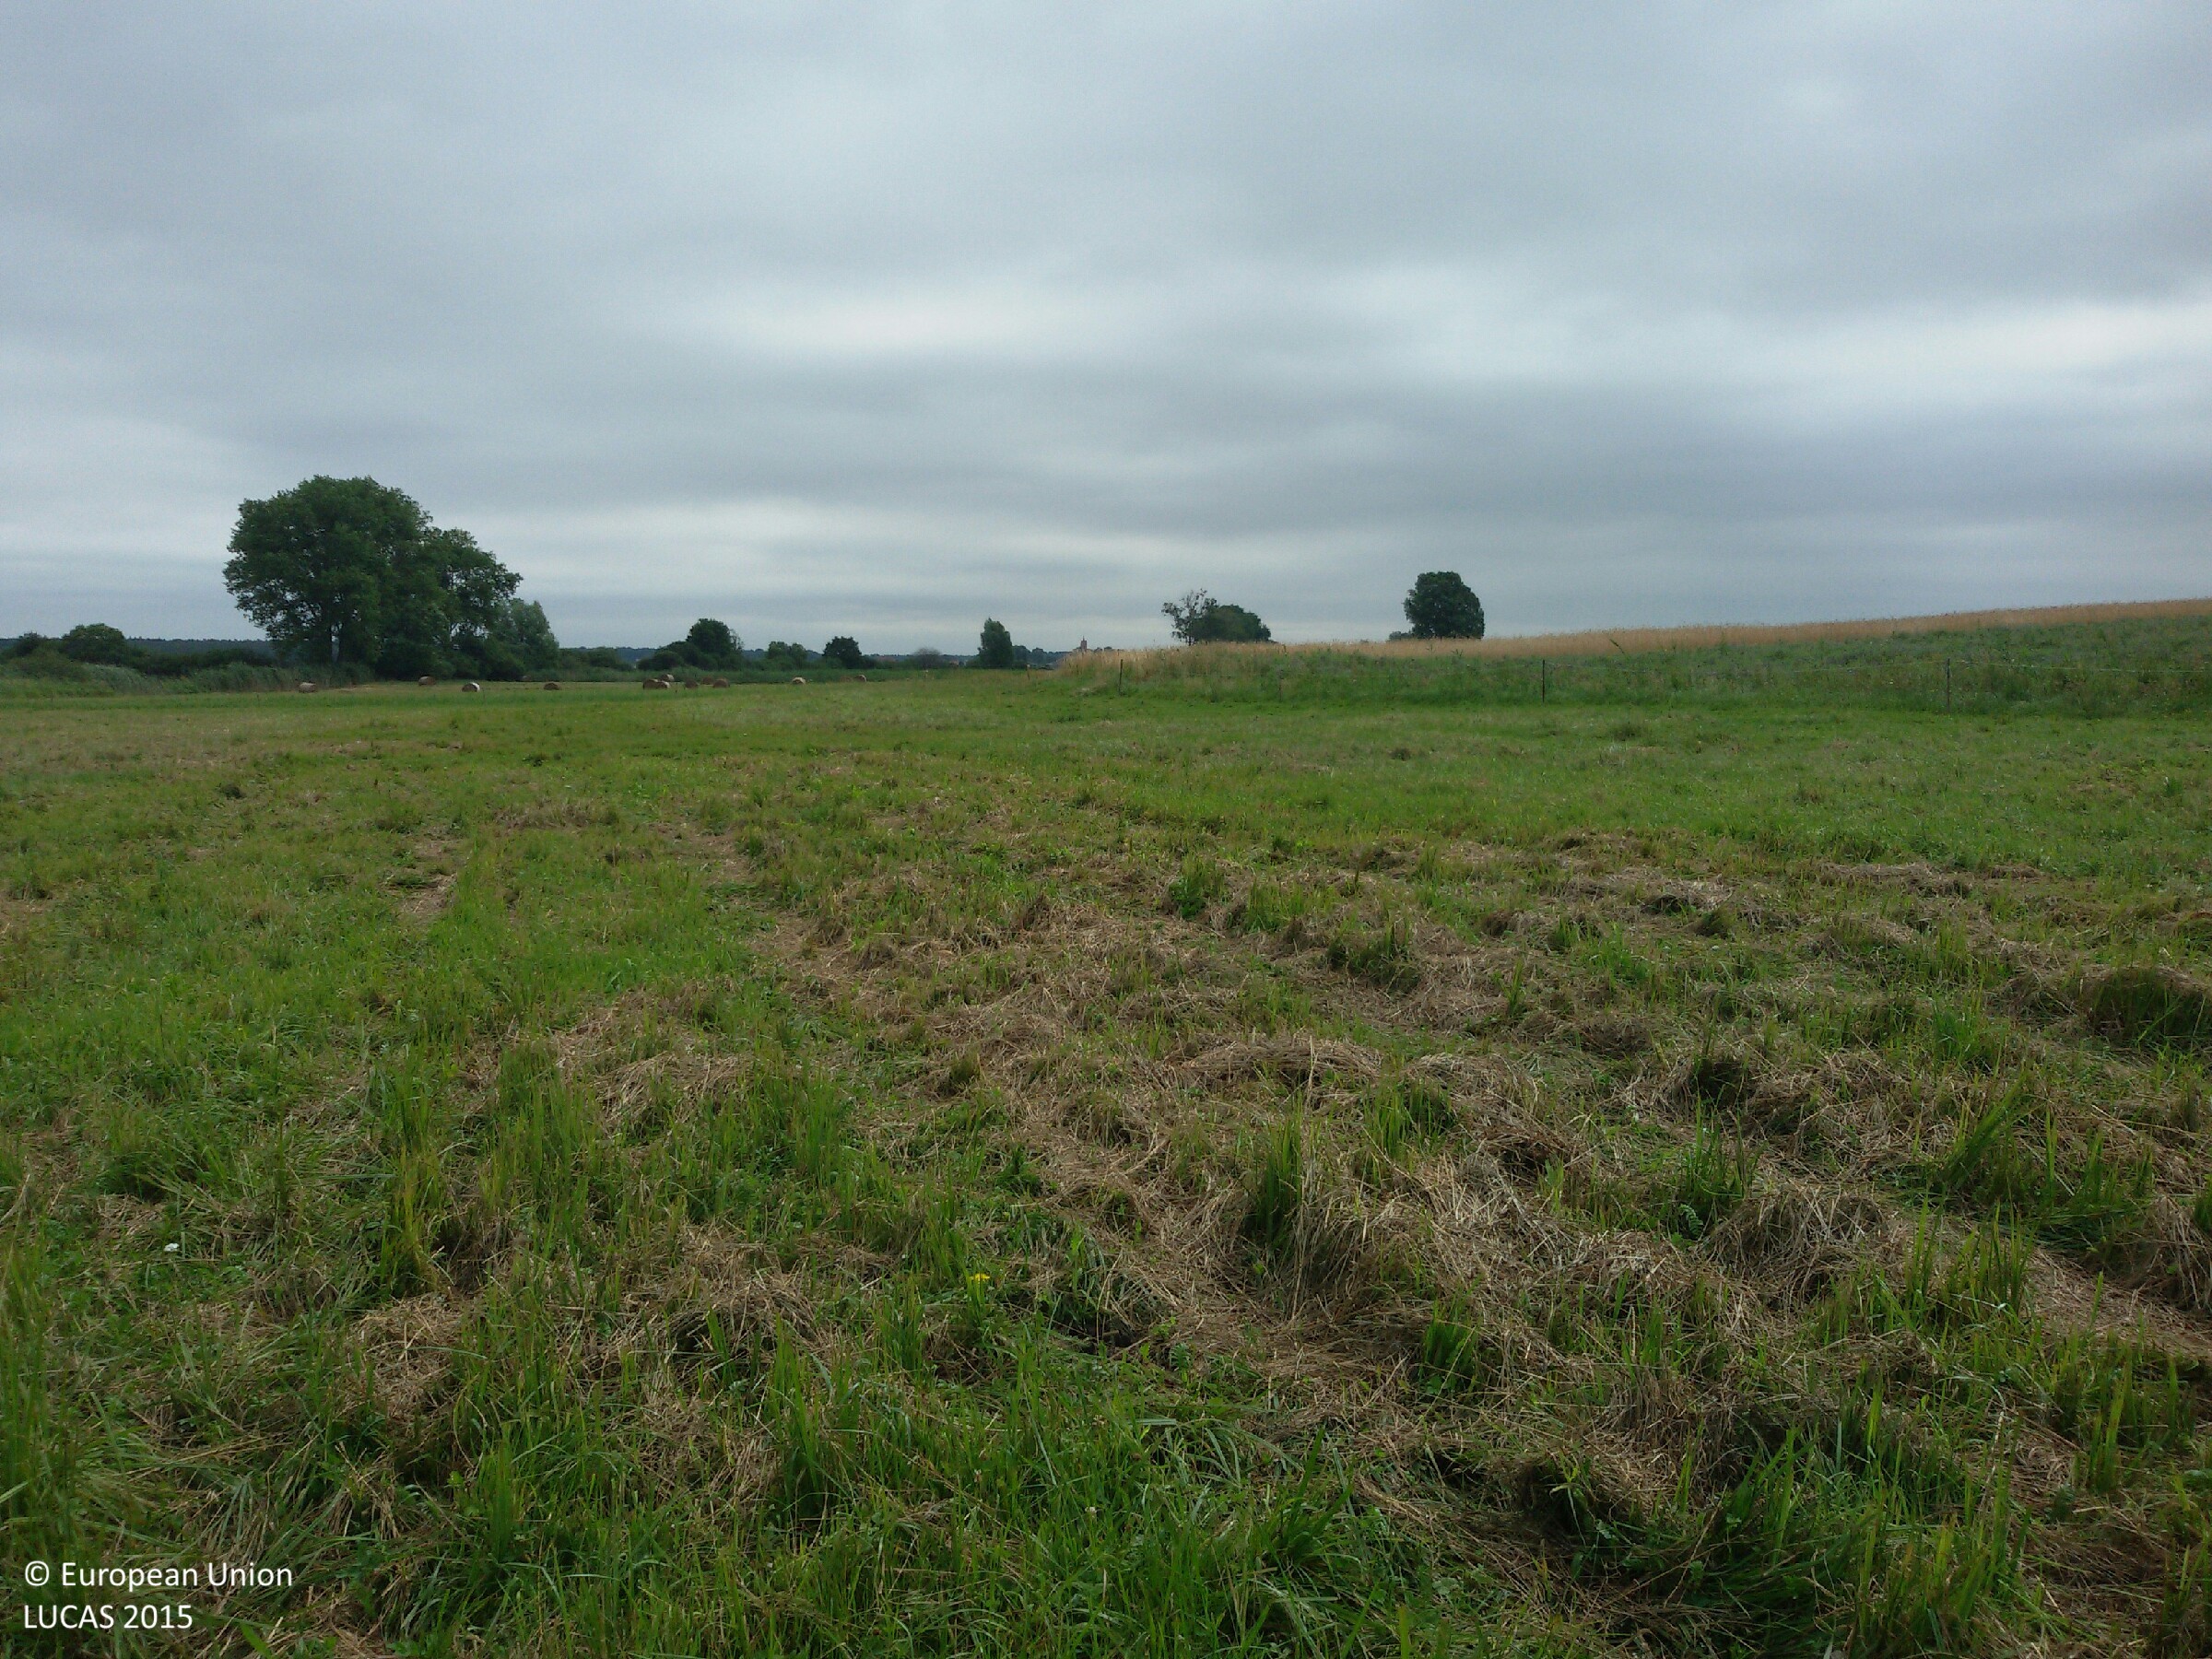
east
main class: Grassland
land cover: Grassland without tree/shrub cover
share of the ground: > 75 %
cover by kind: herbaceous plants 100 %
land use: Agriculture (excluding fallow land and kitchen gardens)
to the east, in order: Grassland without tree/shrub cover; Fences; Rye; Grassland without tree/shrub cover; Spontaneously vegetated surfaces
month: July
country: PL
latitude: 53.0507
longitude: 15.7179
